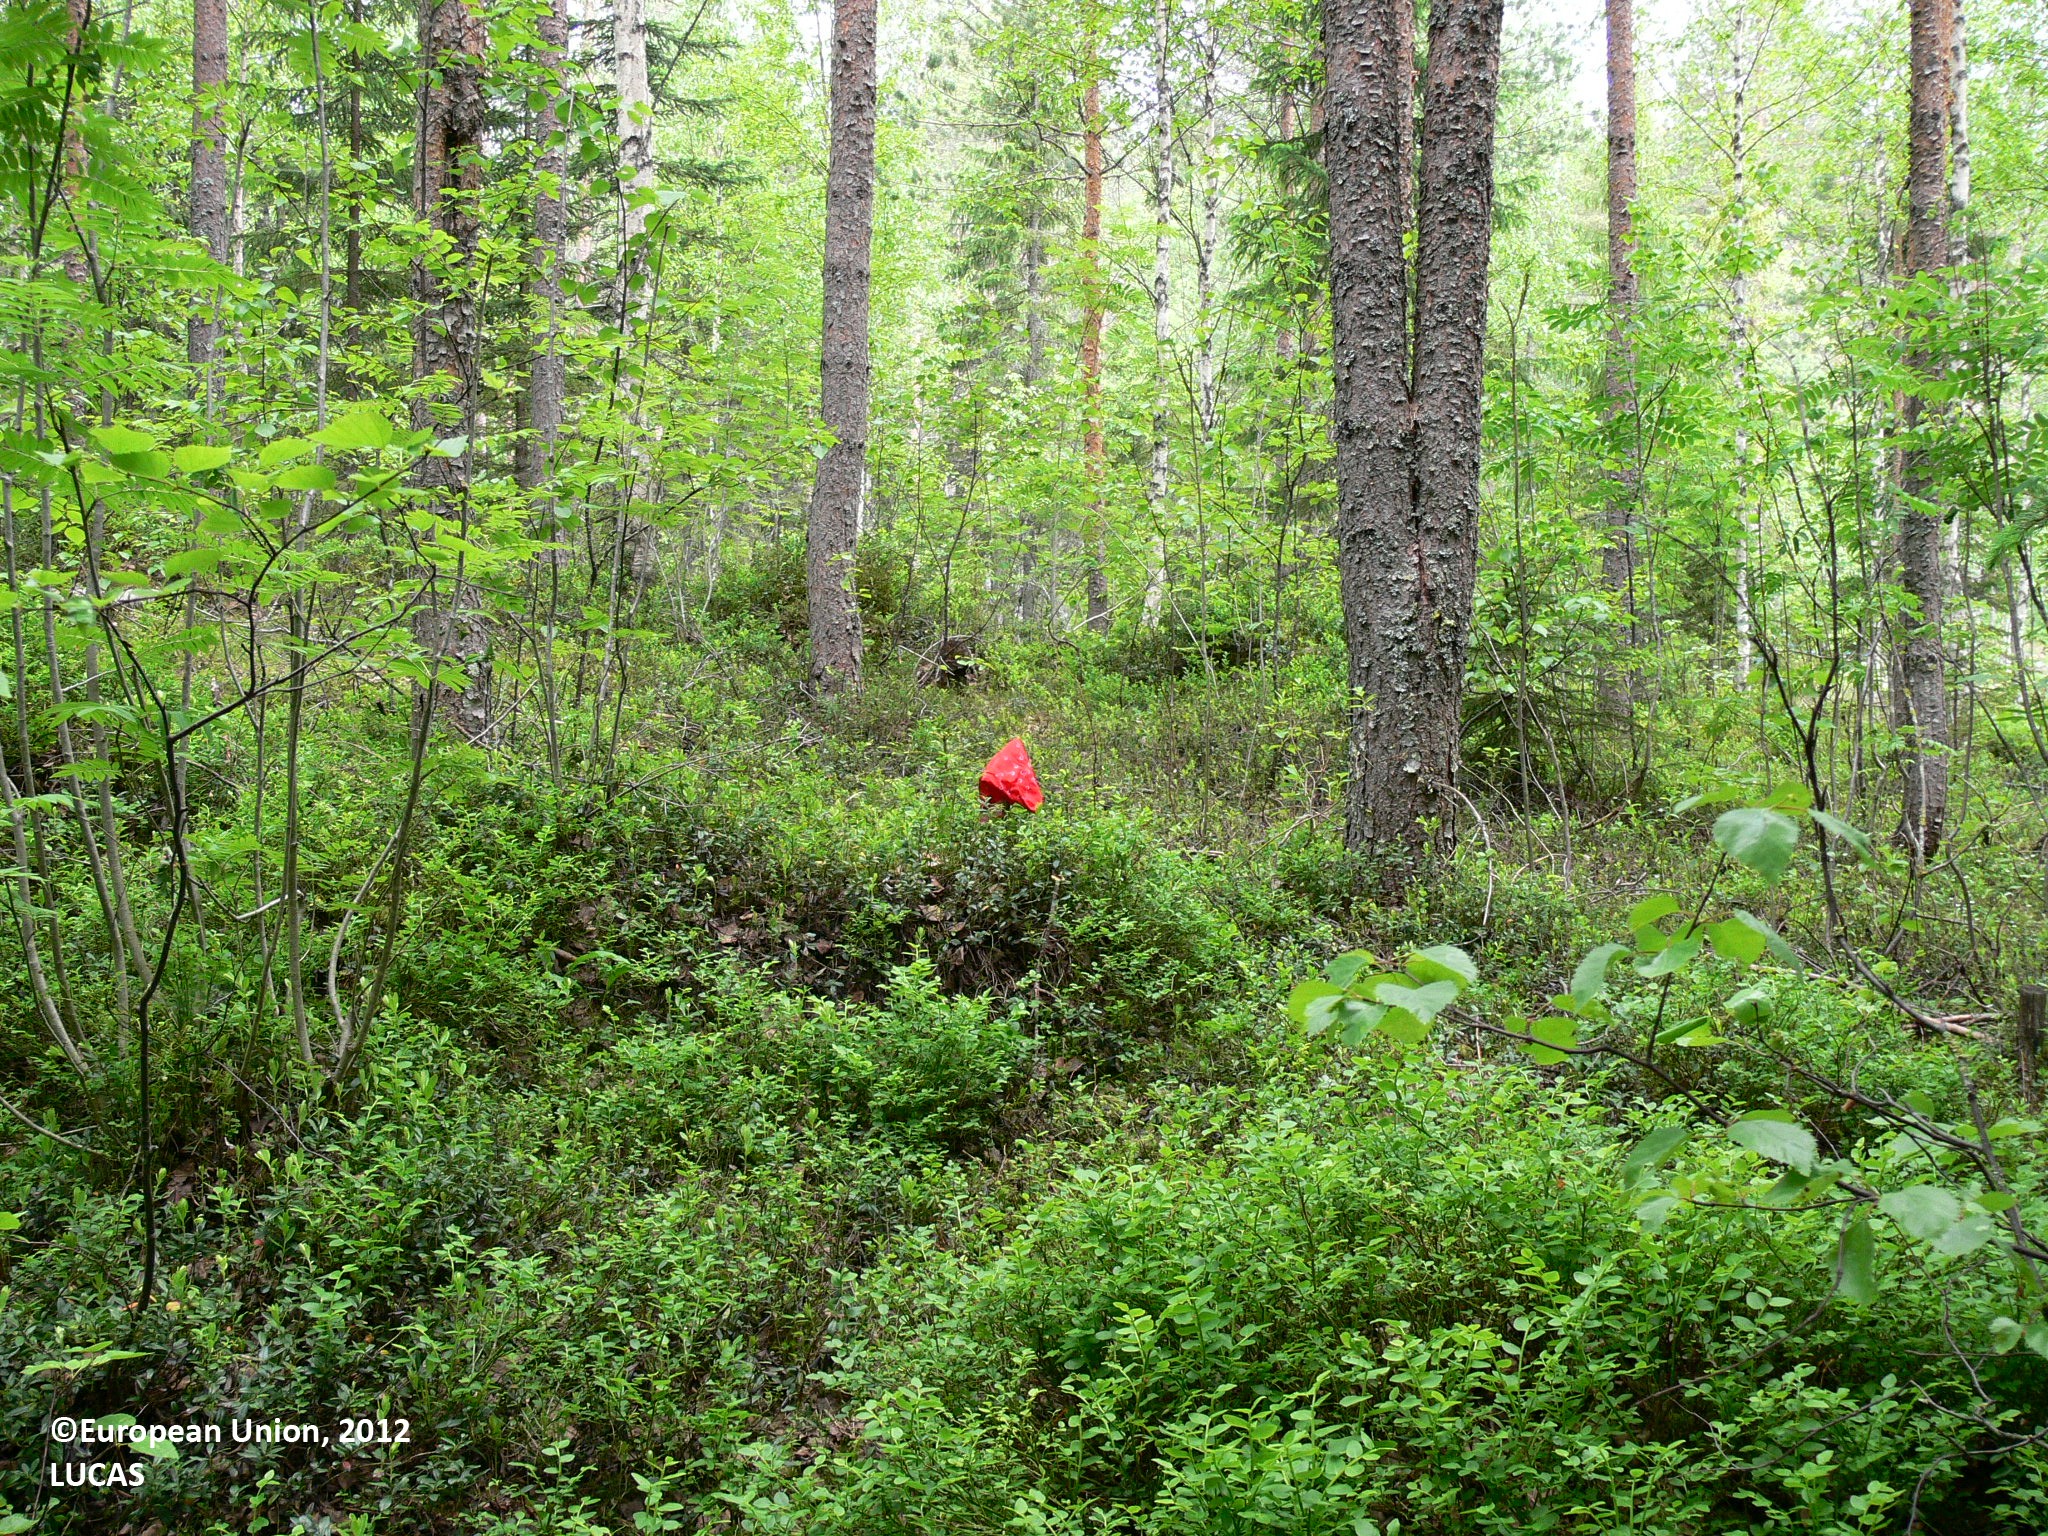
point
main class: Woodland
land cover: Pine dominated mixed woodland
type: boreal forest
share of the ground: > 75 %
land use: Forestry
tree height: > 5 m
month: June
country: FI
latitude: 62.8623
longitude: 29.9647
